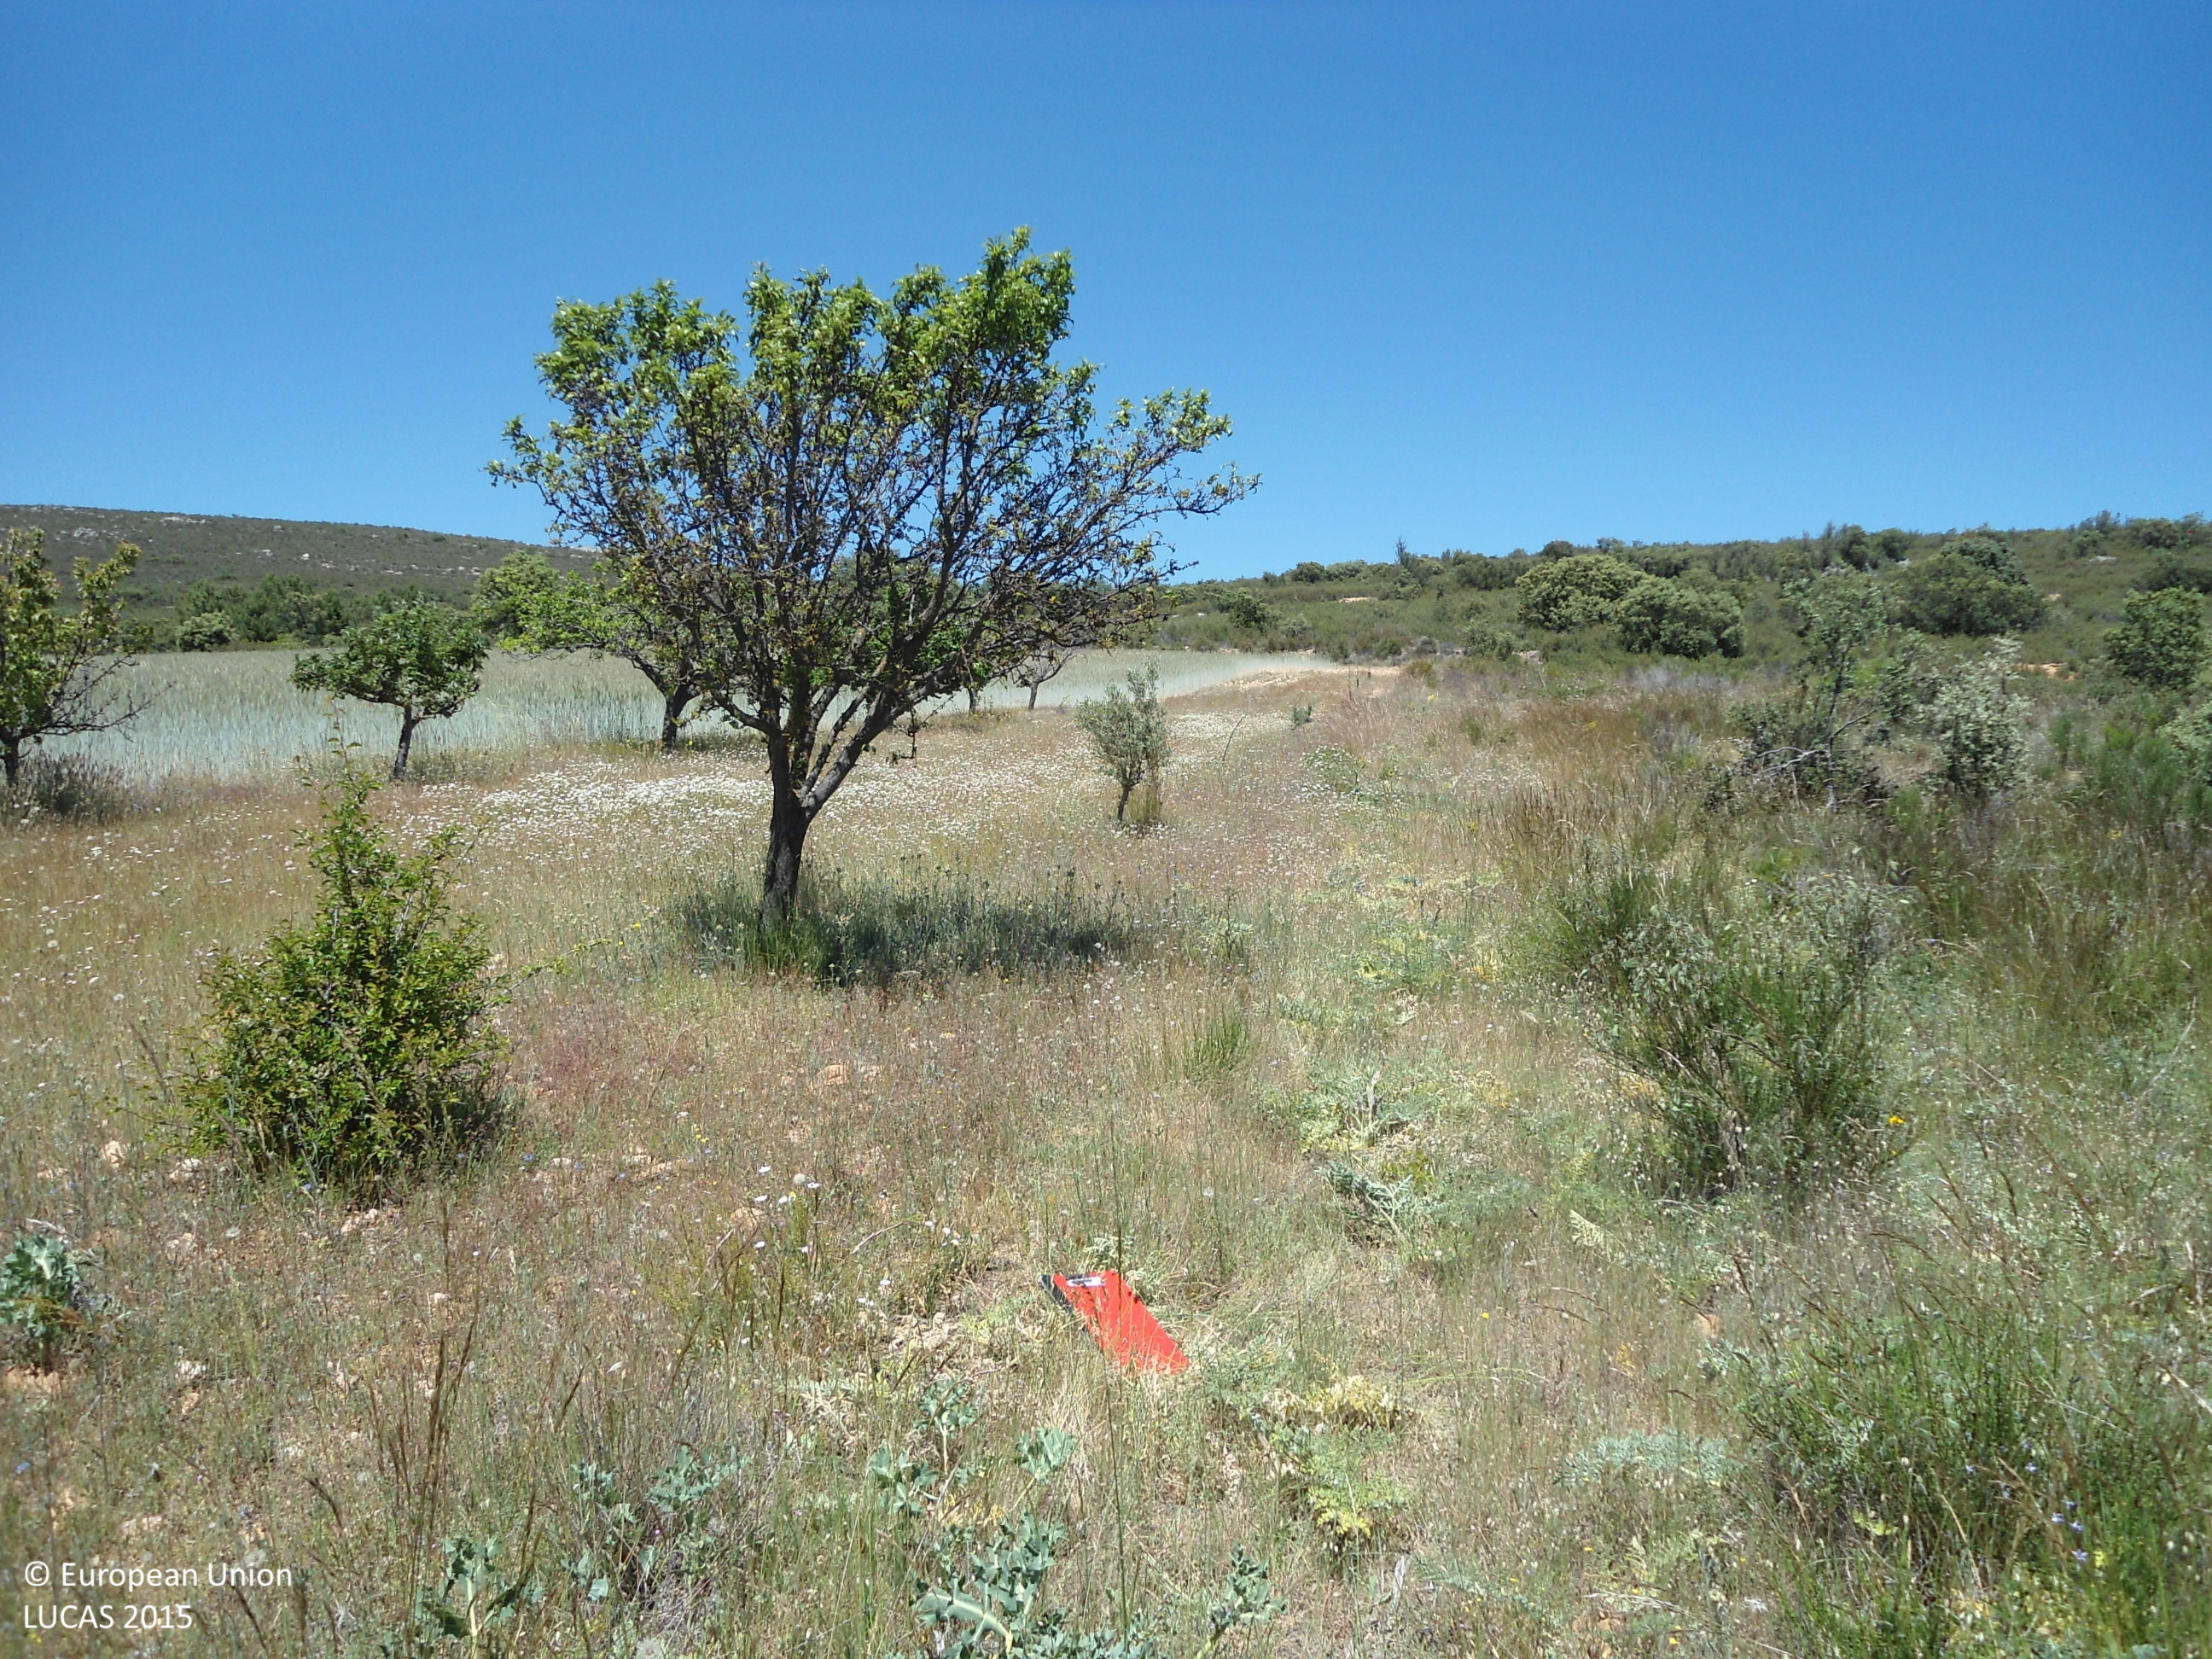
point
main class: Shrubland
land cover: Shrubland without tree cover
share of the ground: > 75 %
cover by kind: shrubs 80 %, herbaceous plants 20 %
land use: Semi-natural and natural areas not in use
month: May
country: ES
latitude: 42.1033
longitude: -6.0262
